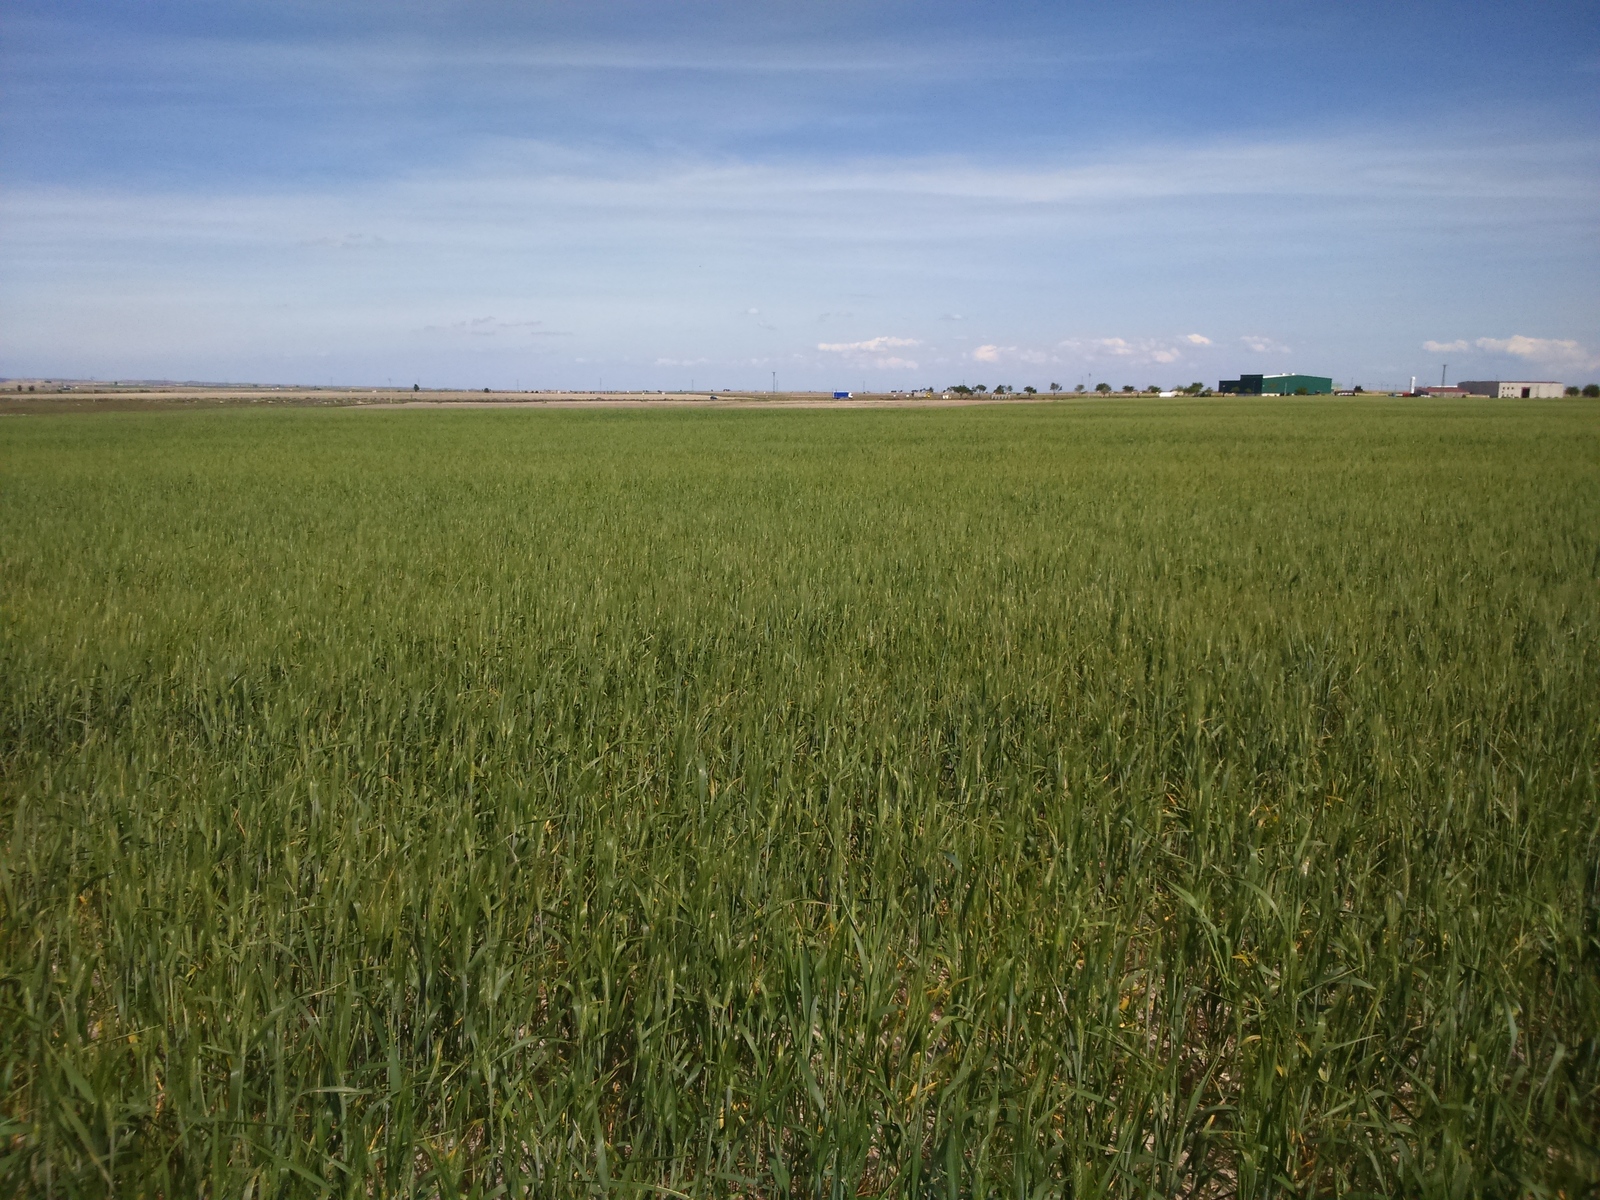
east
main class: Cropland
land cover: Barley
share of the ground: > 75 %
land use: Agriculture (excluding fallow land and kitchen gardens)
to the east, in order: Barley; Grass margins; Other bare soil
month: April
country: ES
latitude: 41.4869
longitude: -0.1600
